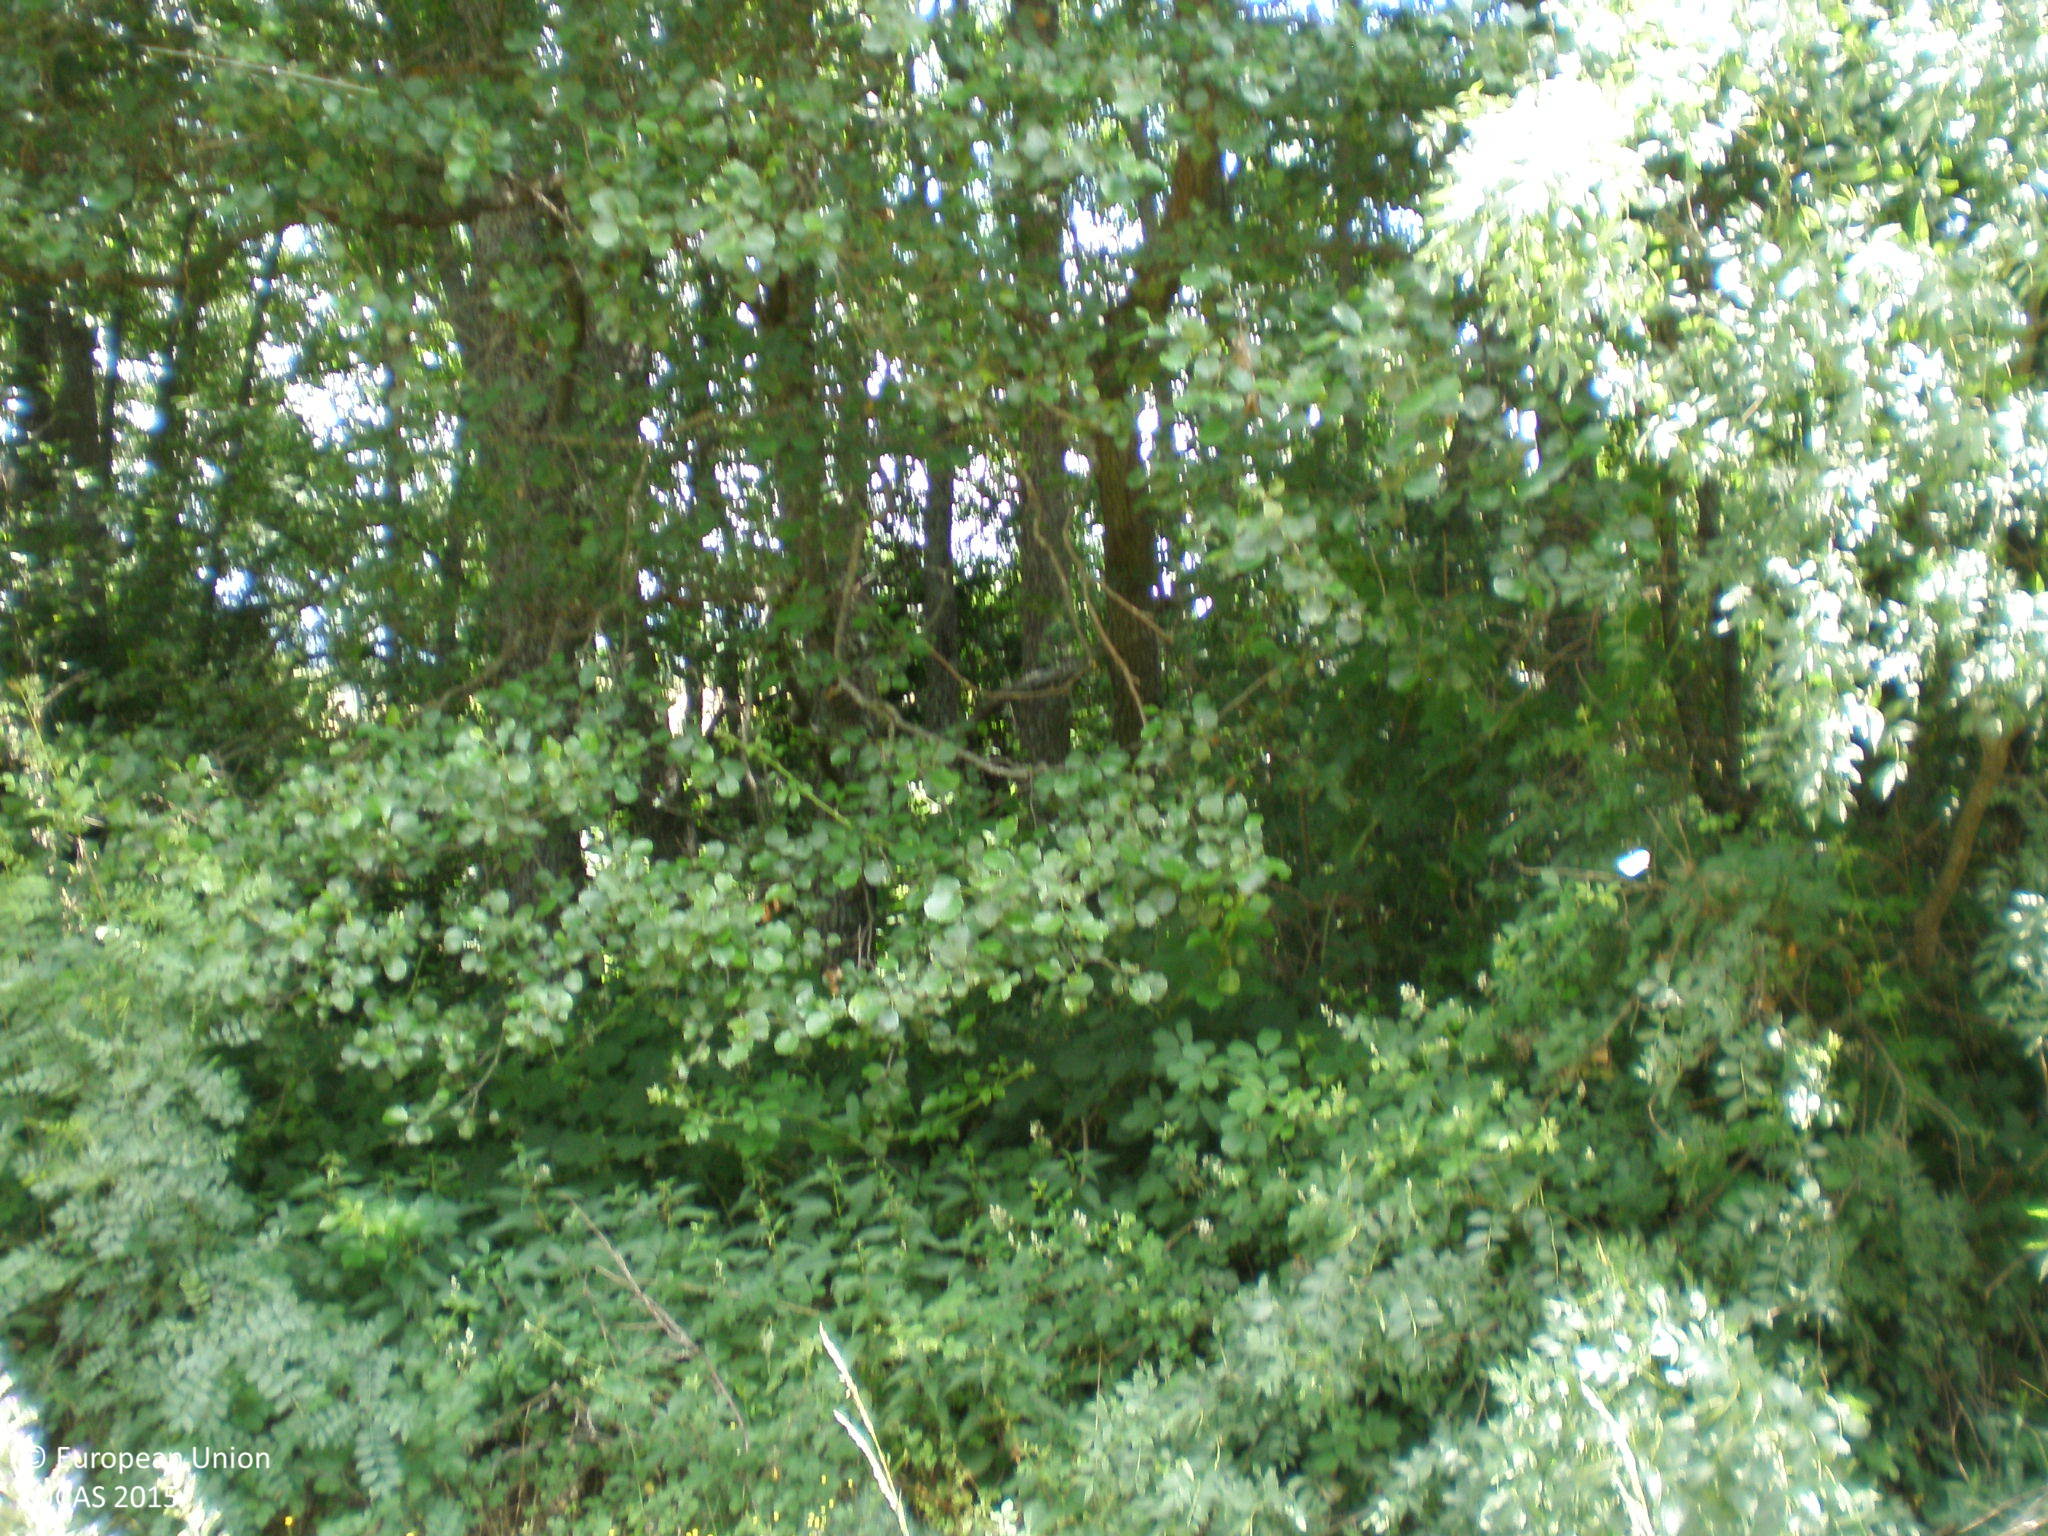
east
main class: Grassland
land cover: Grassland without tree/shrub cover
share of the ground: > 75 %
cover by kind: herbaceous plants 100 %
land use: Semi-natural and natural areas not in use
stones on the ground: < 10 %
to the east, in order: Grassland without tree/shrub cover; Broadleaved woodland; Inland fresh running water; Grassland without tree/shrub cover; Fences; Grassland without tree/shrub cover; Dry stone walls; Grass margins; Tracks; Grass margins; Grassland without tree/shrub cover
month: June
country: ES
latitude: 40.3430
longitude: -5.5465
